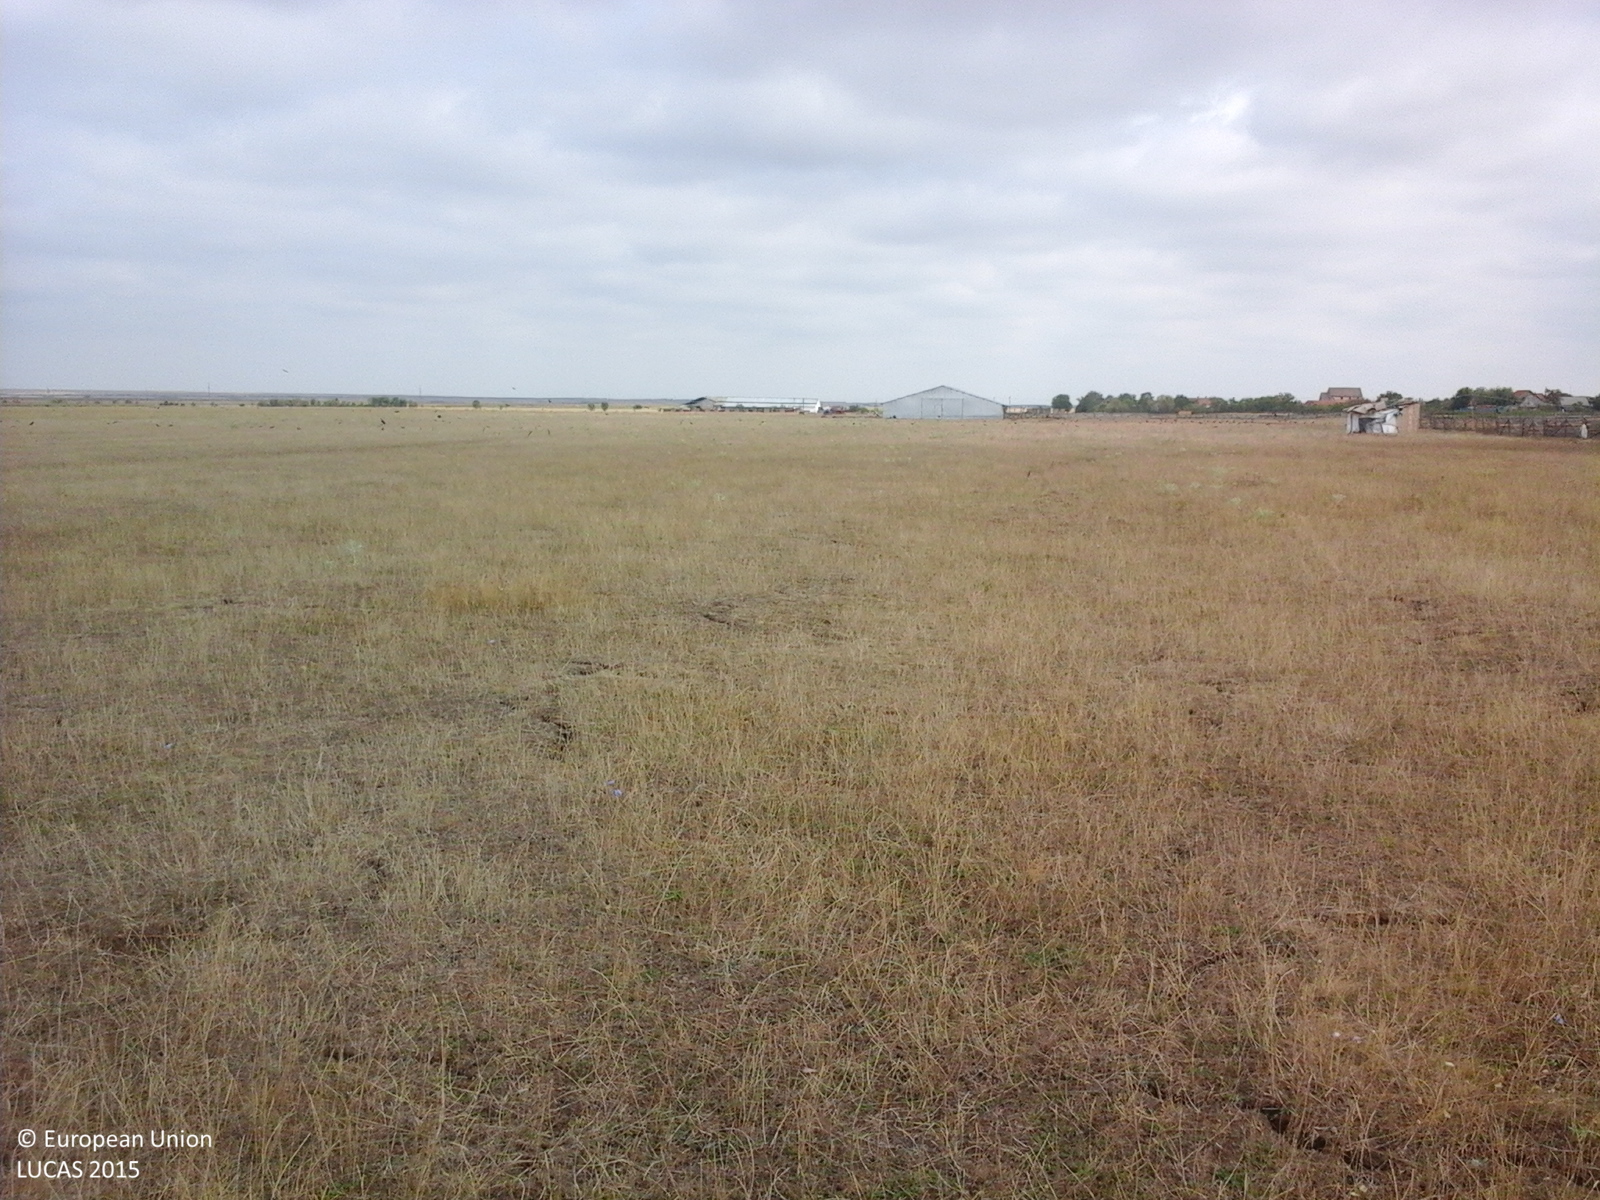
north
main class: Grassland
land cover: Grassland without tree/shrub cover
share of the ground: > 75 %
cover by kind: herbaceous plants 100 %
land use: Agriculture (excluding fallow land and kitchen gardens)
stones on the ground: < 10 %
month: August
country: RO
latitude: 45.4023
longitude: 21.4913
